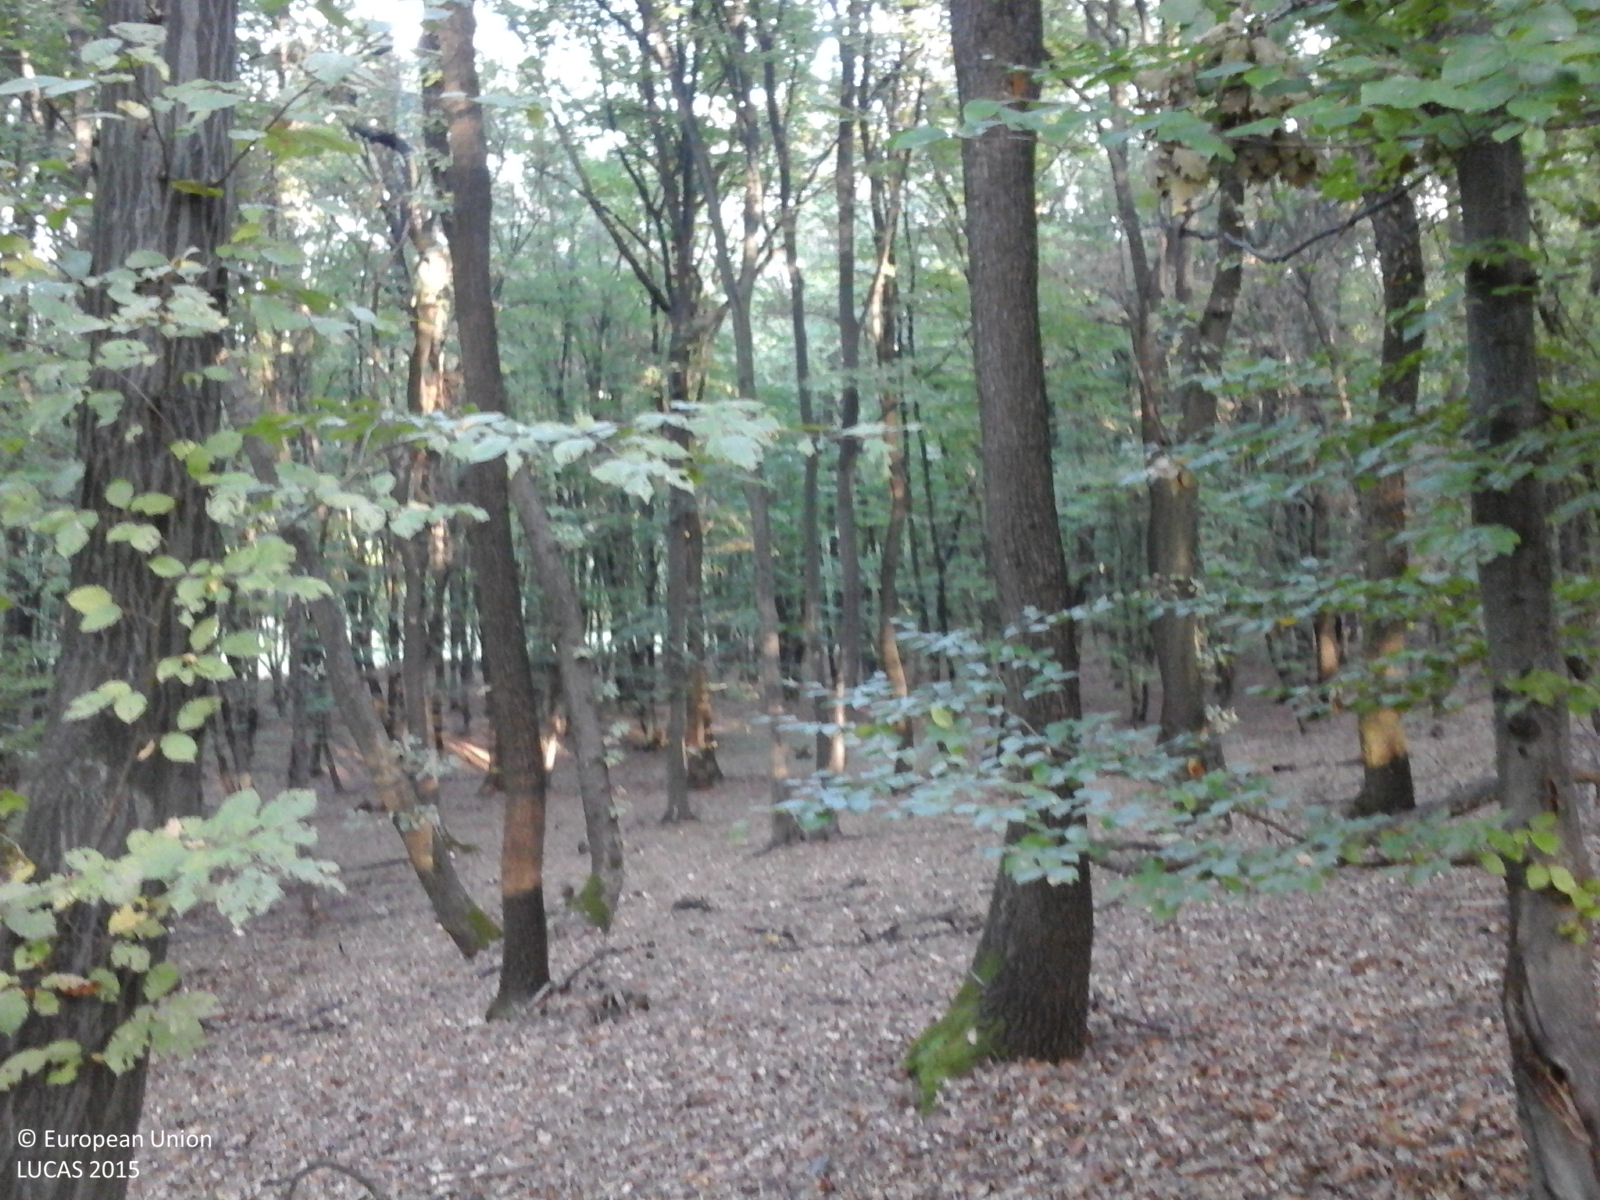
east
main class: Woodland
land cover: Broadleaved woodland
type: acidophilous oak and oak-birch forest
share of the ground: > 75 %
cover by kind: broadleaved forest trees 100 %
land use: Forestry
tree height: > 5 m
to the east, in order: Broadleaved woodland; Tracks; Broadleaved woodland; Tracks; Broadleaved woodland
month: October
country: RO
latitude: 46.1821
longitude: 24.2127
